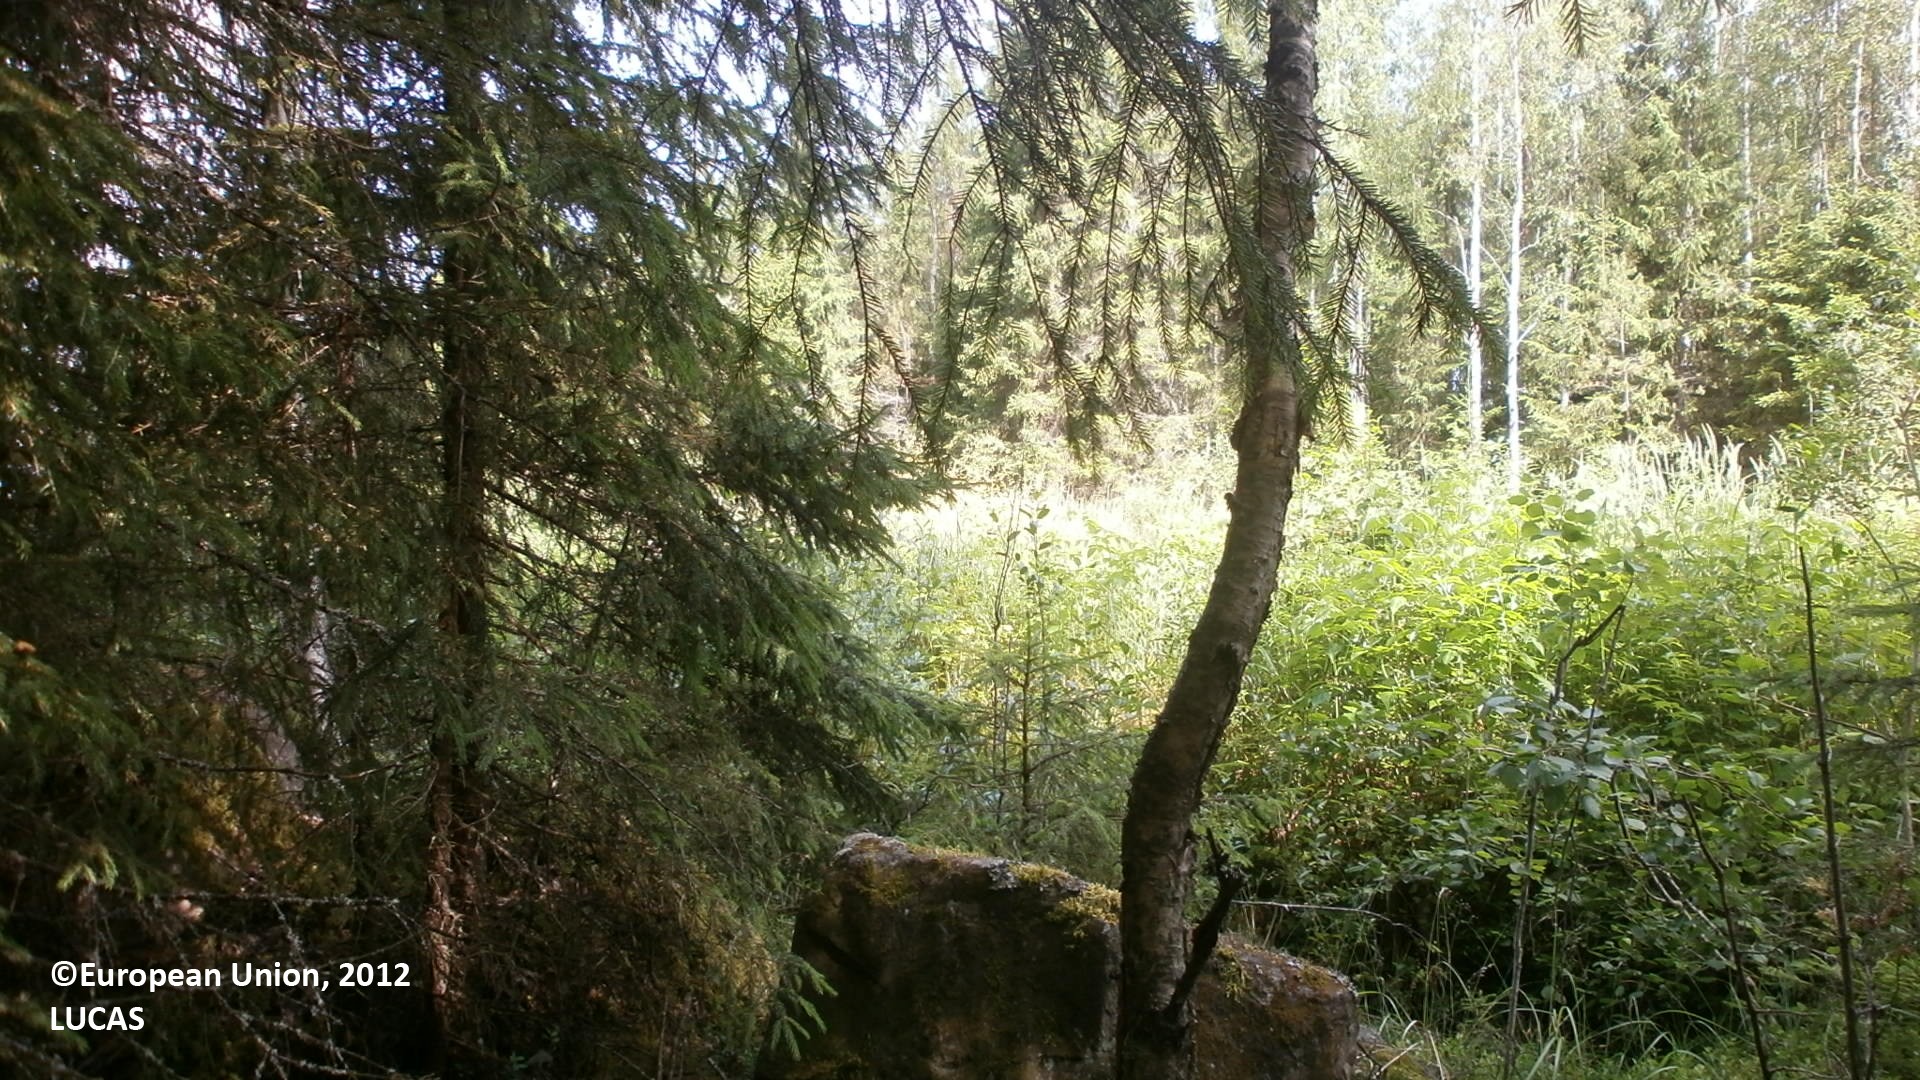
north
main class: Woodland
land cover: Spruce dominated mixed woodland
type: boreal forest
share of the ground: > 75 %
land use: Forestry
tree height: > 5 m
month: July
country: FI
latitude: 64.0230
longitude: 24.2920
